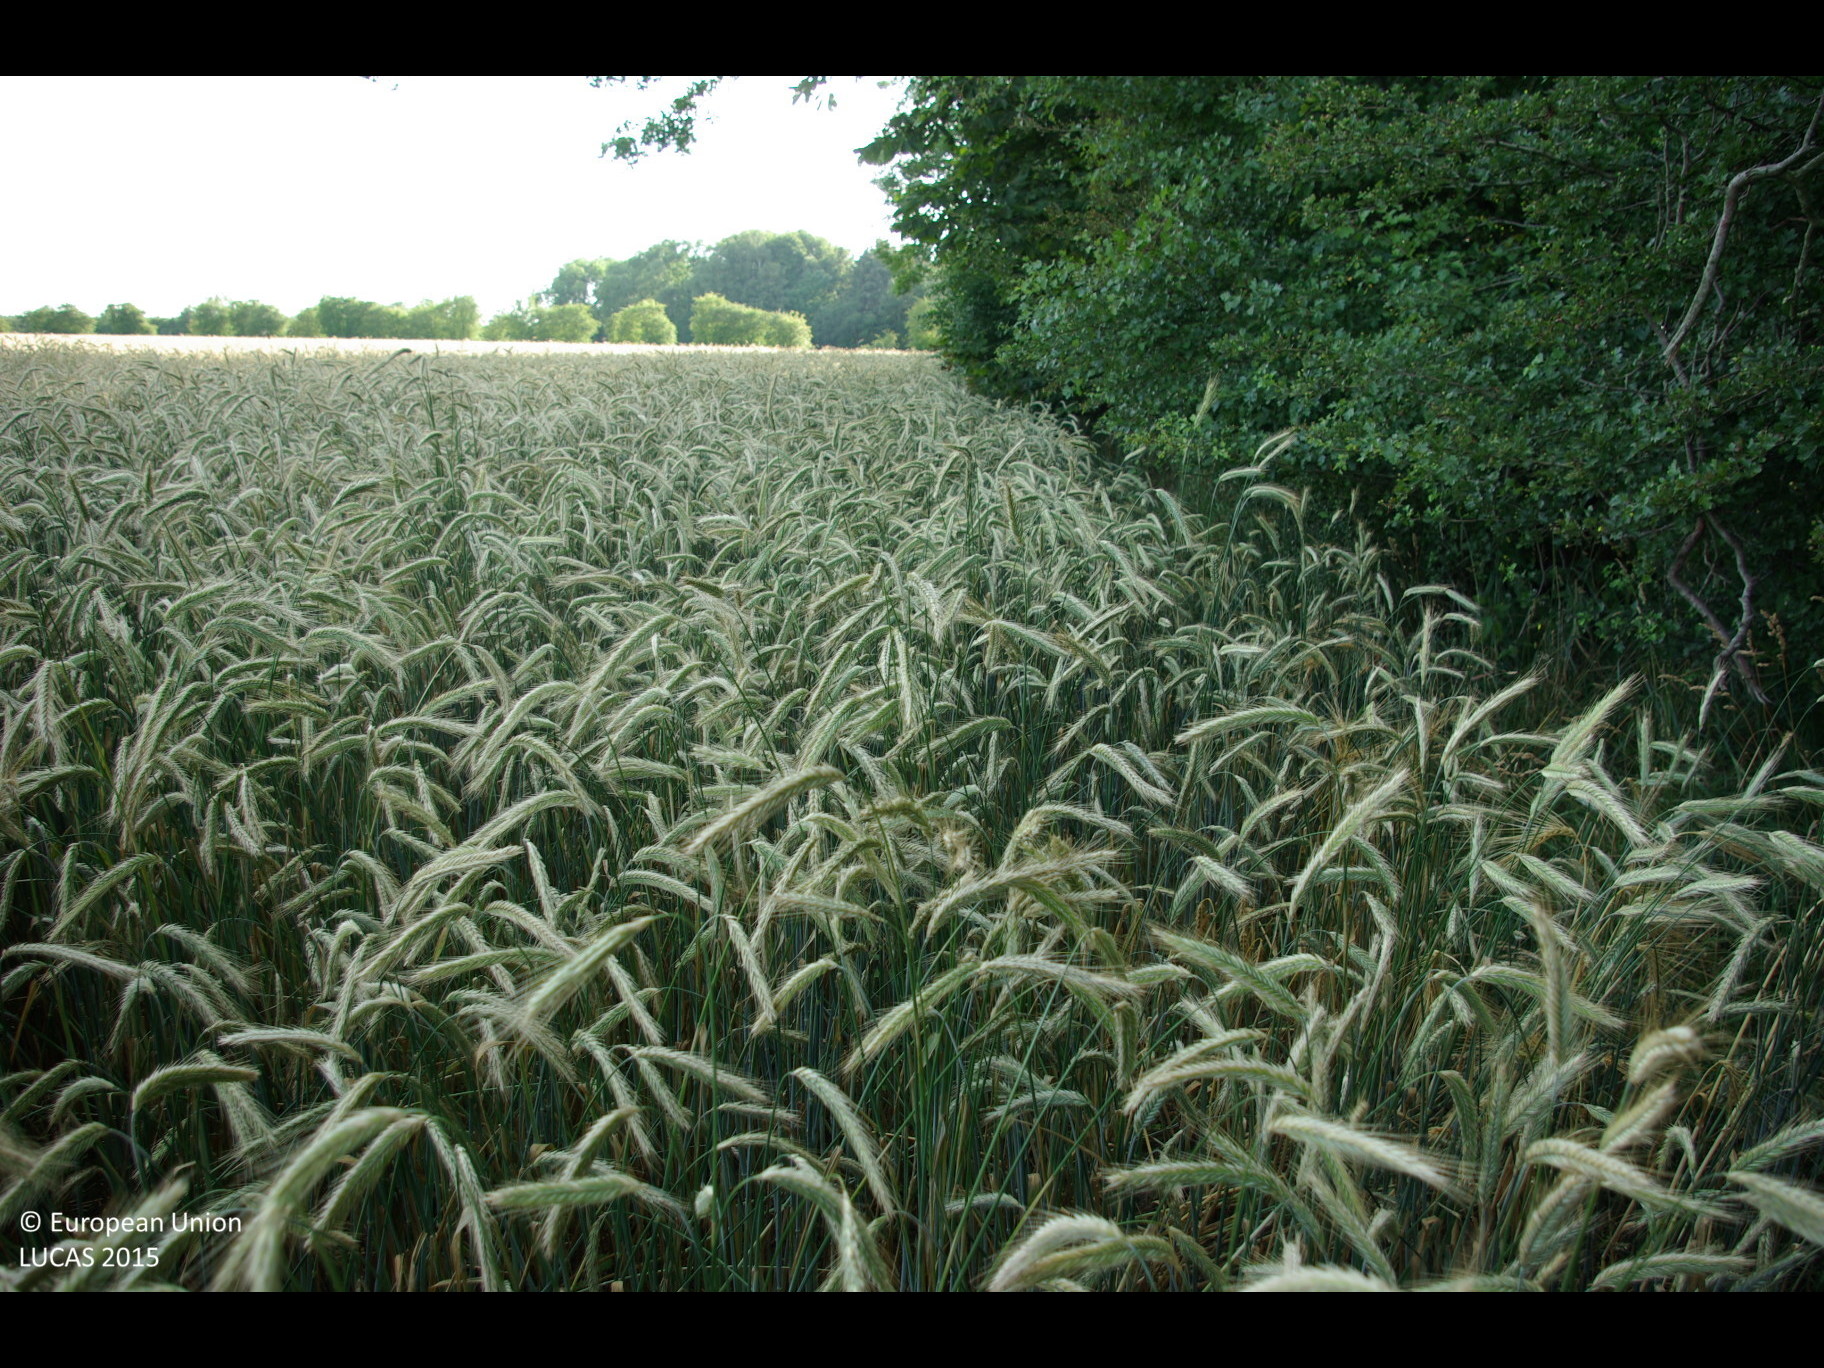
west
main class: Cropland
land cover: Rye
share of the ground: > 75 %
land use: Agriculture (excluding fallow land and kitchen gardens)
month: July
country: DE
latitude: 54.7836
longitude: 9.2697
